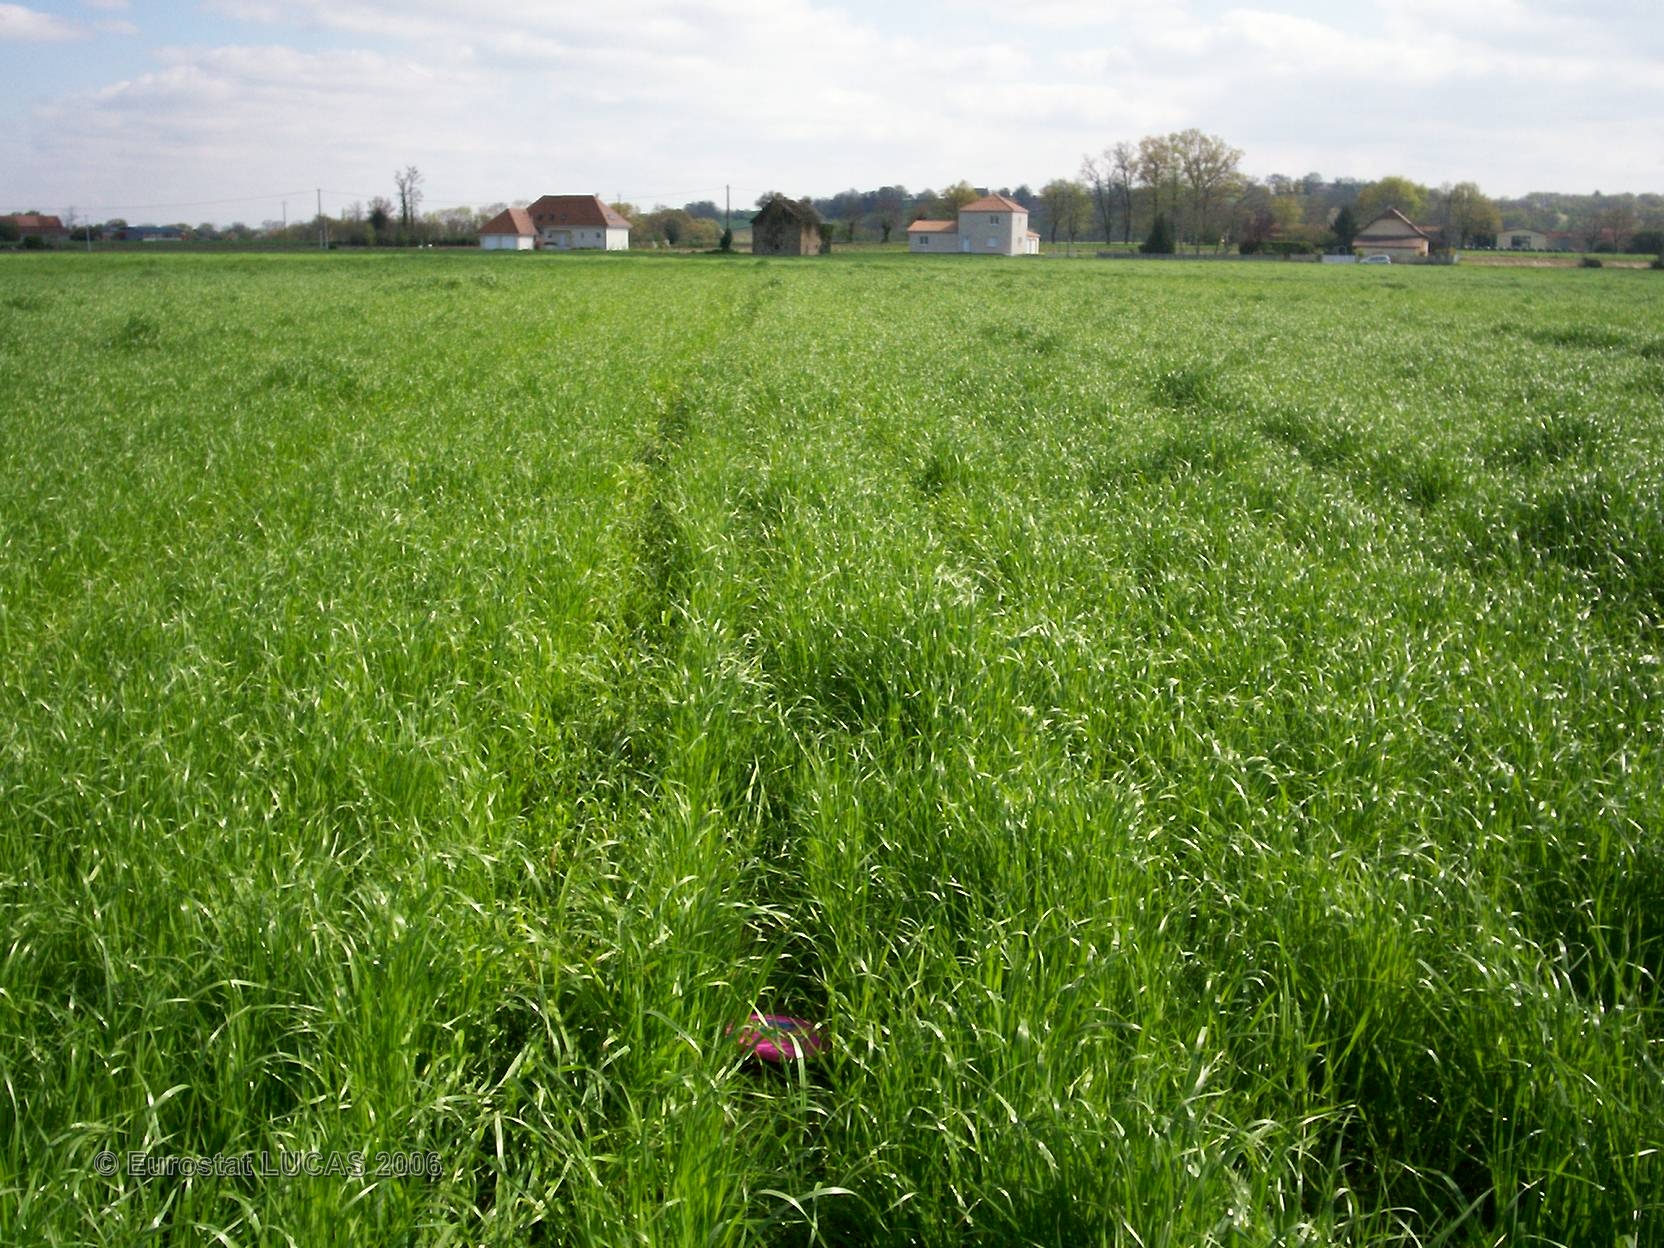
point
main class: Cropland
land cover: Other leguminous and mixtures for fodder
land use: Agriculture (excluding fallow land and kitchen gardens)
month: April
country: FR
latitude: 43.4345
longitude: -0.3230
